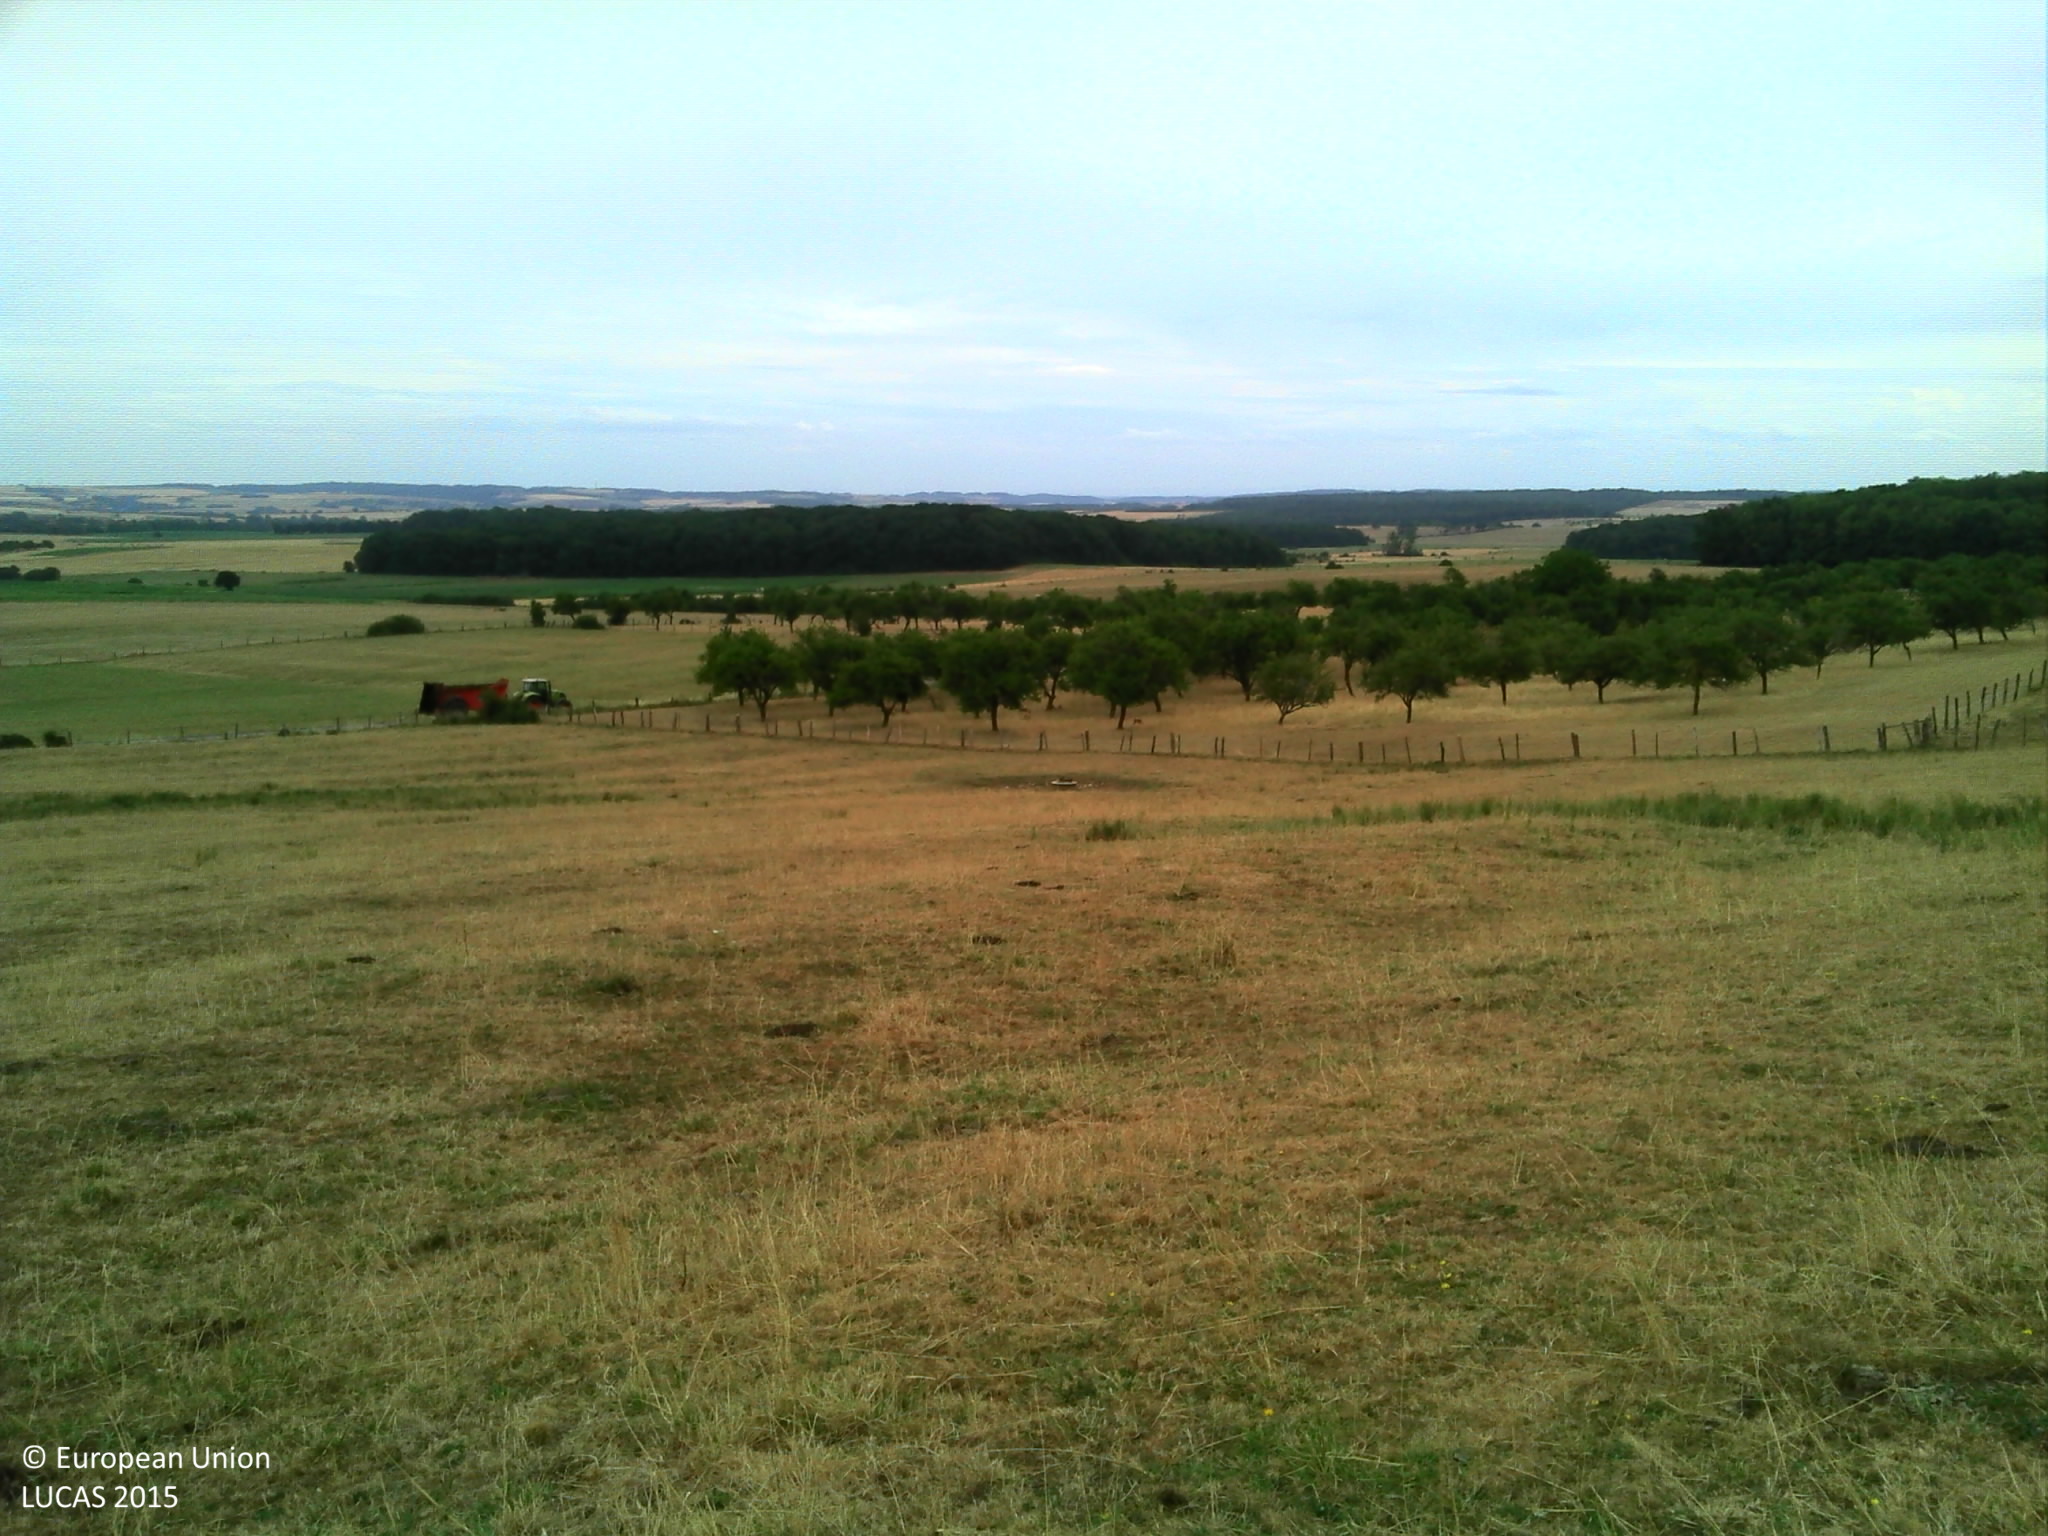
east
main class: Grassland
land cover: Grassland without tree/shrub cover
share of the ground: > 75 %
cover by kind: herbaceous plants 100 %
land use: Agriculture (excluding fallow land and kitchen gardens)
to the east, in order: Grassland without tree/shrub cover; Fences; Other fruit trees and berries; Fences; Shruby margins; Ditches and canals; Grass margins; Paved roads, cycling and walking lanes; Grass margins; Grassland without tree/shrub cover
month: July
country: FR
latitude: 48.3877
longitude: 6.0705
